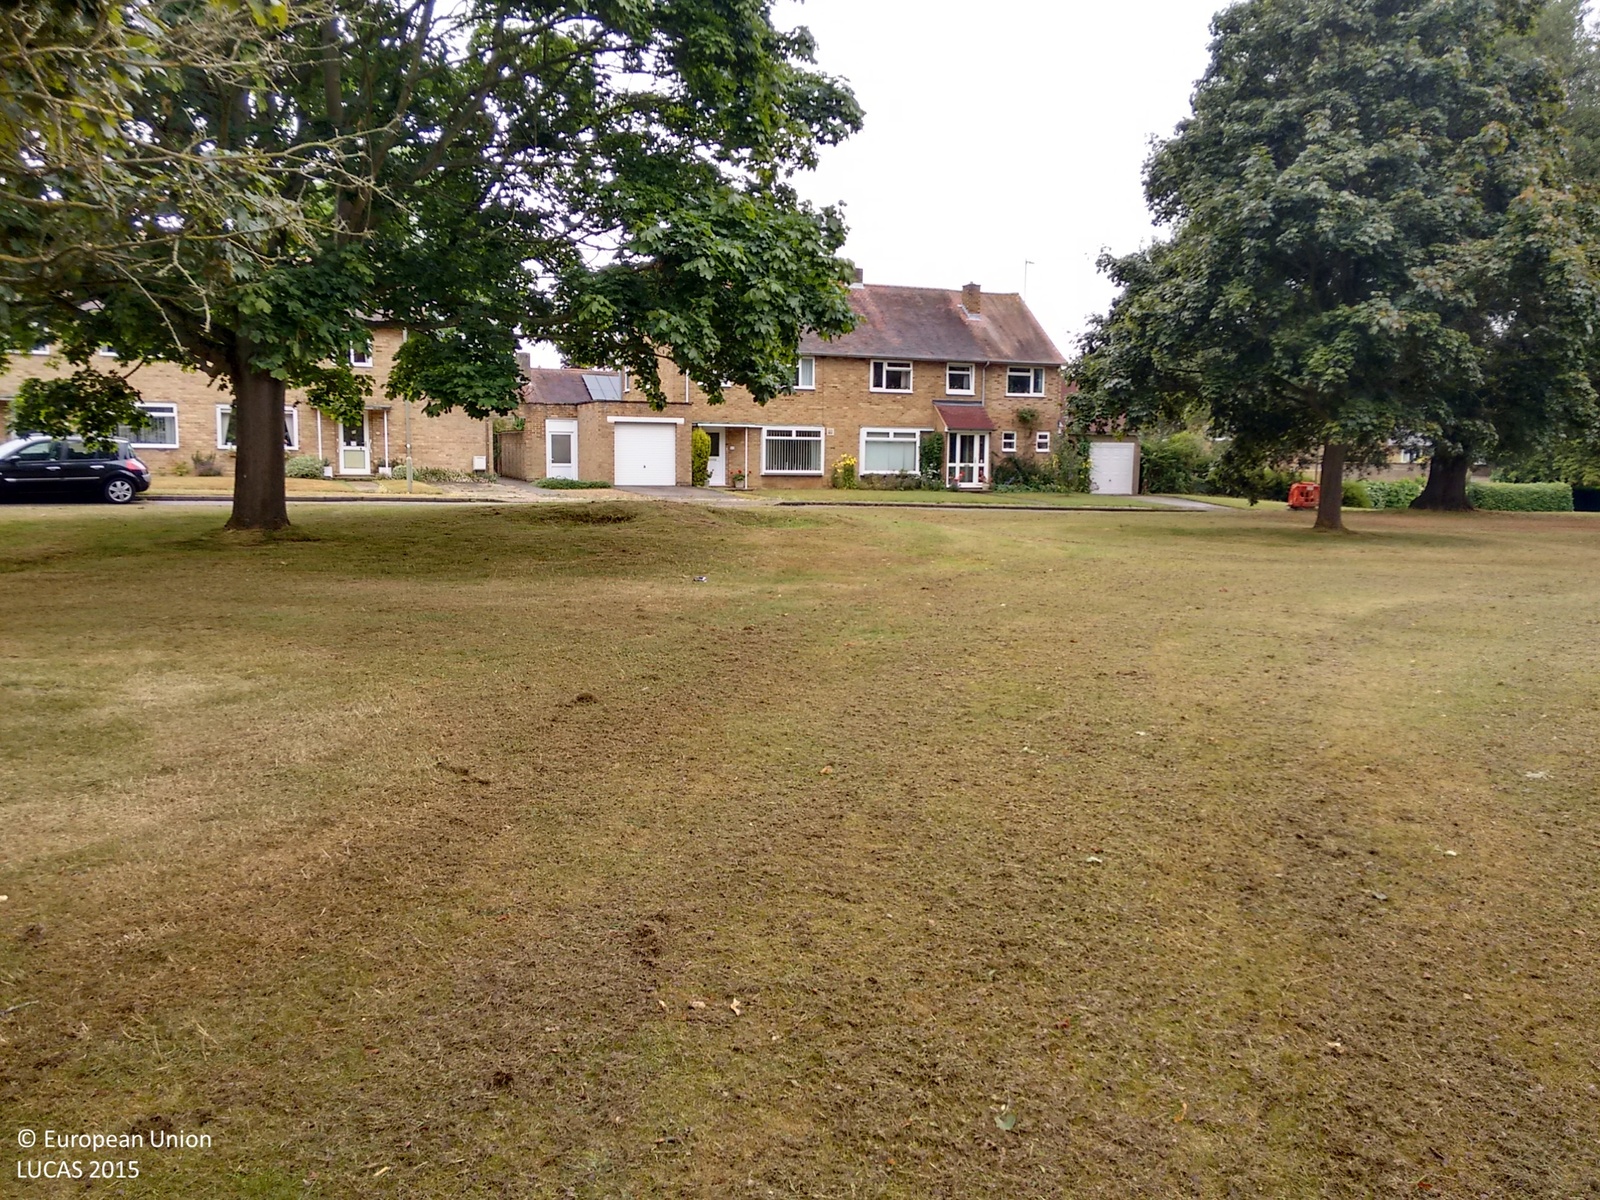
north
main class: Grassland
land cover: Grassland with sparse tree/shrub cover
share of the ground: > 75 %
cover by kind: herbaceous plants 95 %, broadleaved forest trees 5 %
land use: Residential
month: July
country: GB
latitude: 51.6740
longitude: -1.2842
